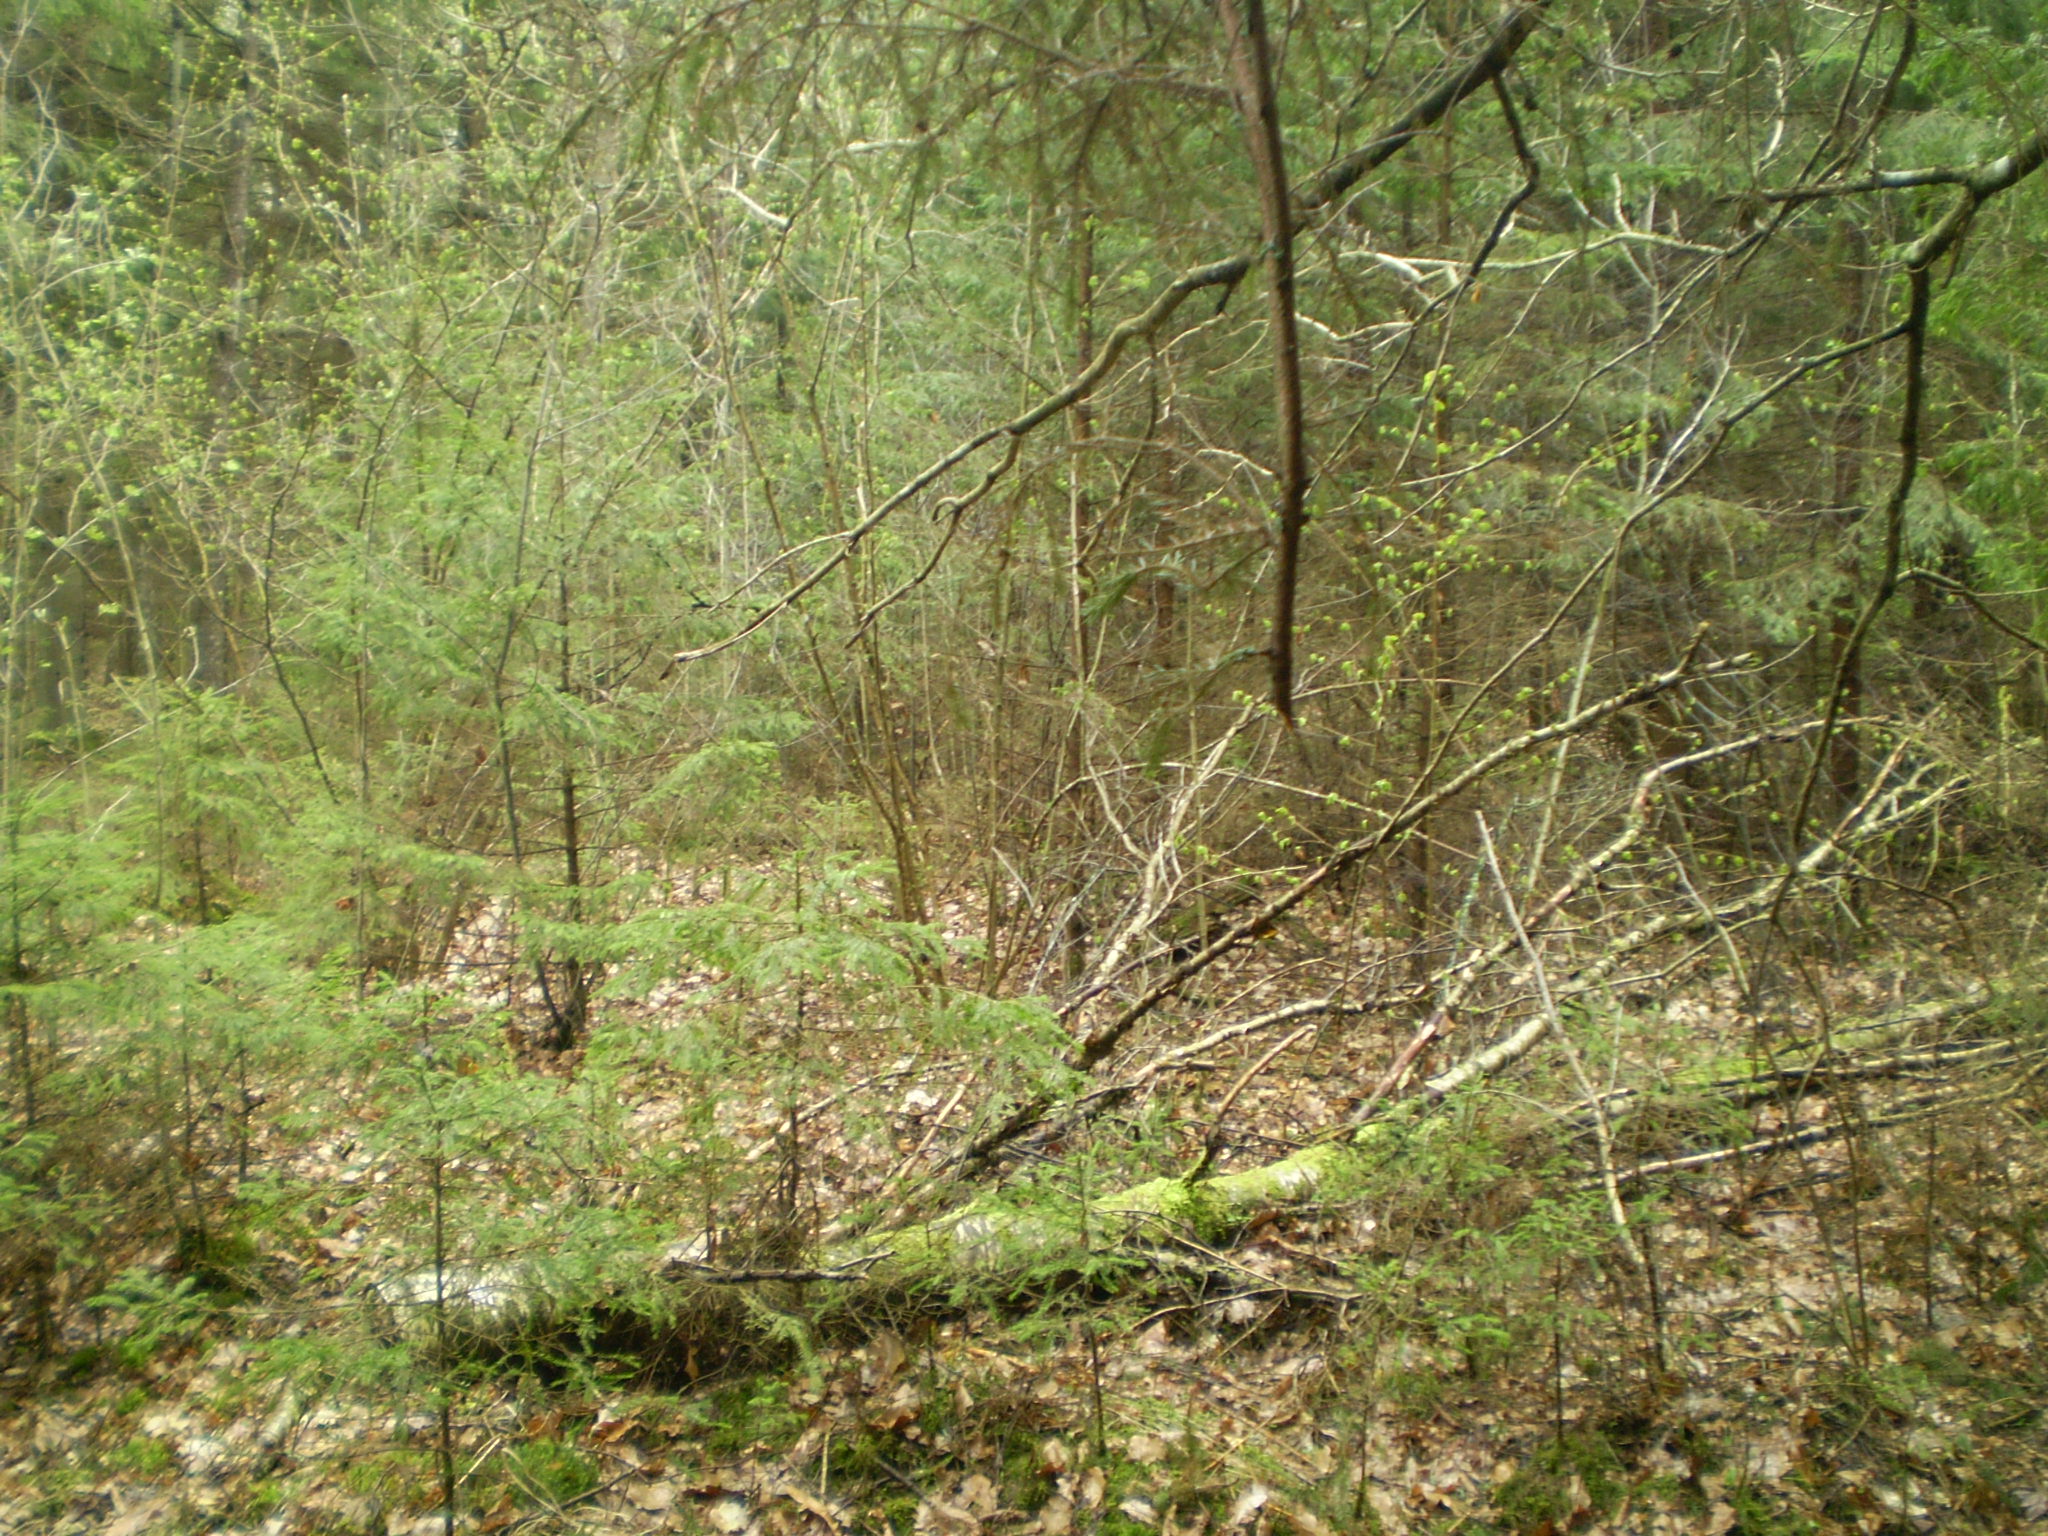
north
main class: Woodland
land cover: Spruce dominated coniferous woodland
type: hemiboreal forest and nemoral coniferous forest and mixed broadleaved-coniferous forest
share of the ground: > 75 %
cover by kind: coniferous forest trees 85 %, broadleaved forest trees 15 %
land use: Forestry
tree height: > 5 m
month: May
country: LT
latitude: 56.2874
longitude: 22.0870
